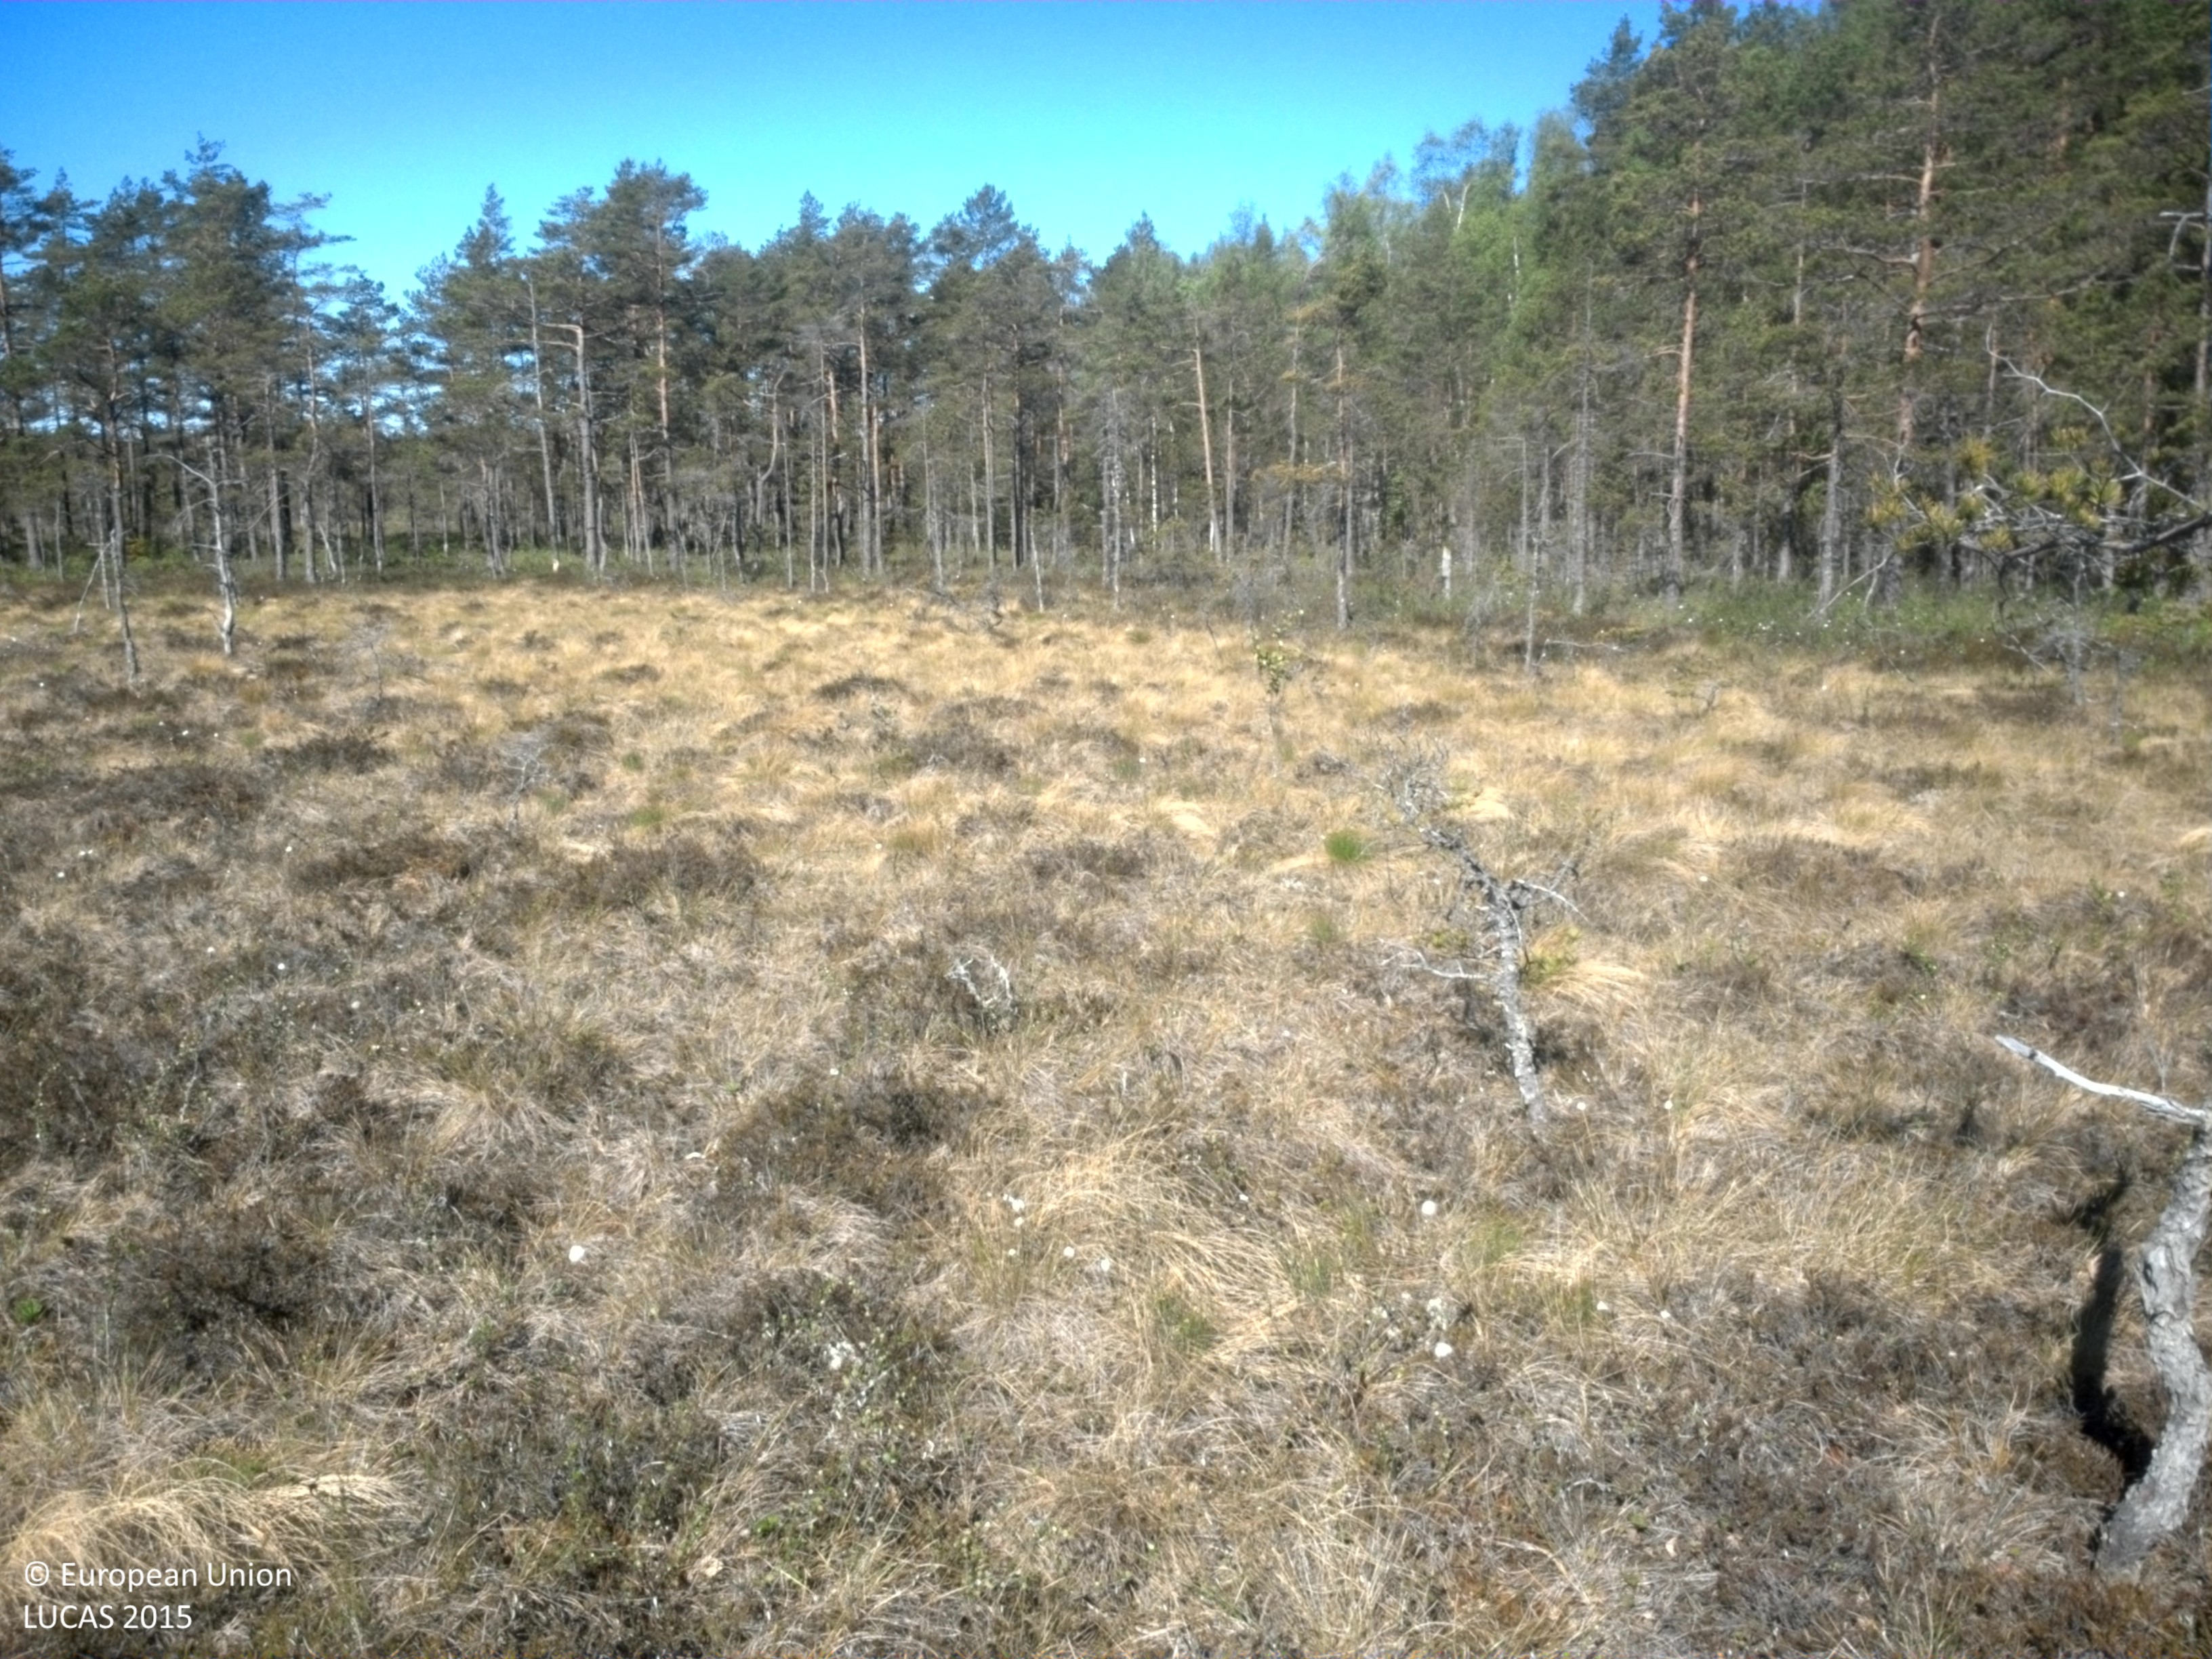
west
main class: Woodland
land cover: Pine dominated coniferous woodland
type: mire and swamp forests
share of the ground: 10 - 25 %
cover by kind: shrubs 40 %, herbaceous plants 35 %, coniferous forest trees 15 %, lichens and mosses 10 %
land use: Semi-natural and natural areas not in use
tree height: < 5 m
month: June
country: SE
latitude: 59.4182
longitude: 14.0973
